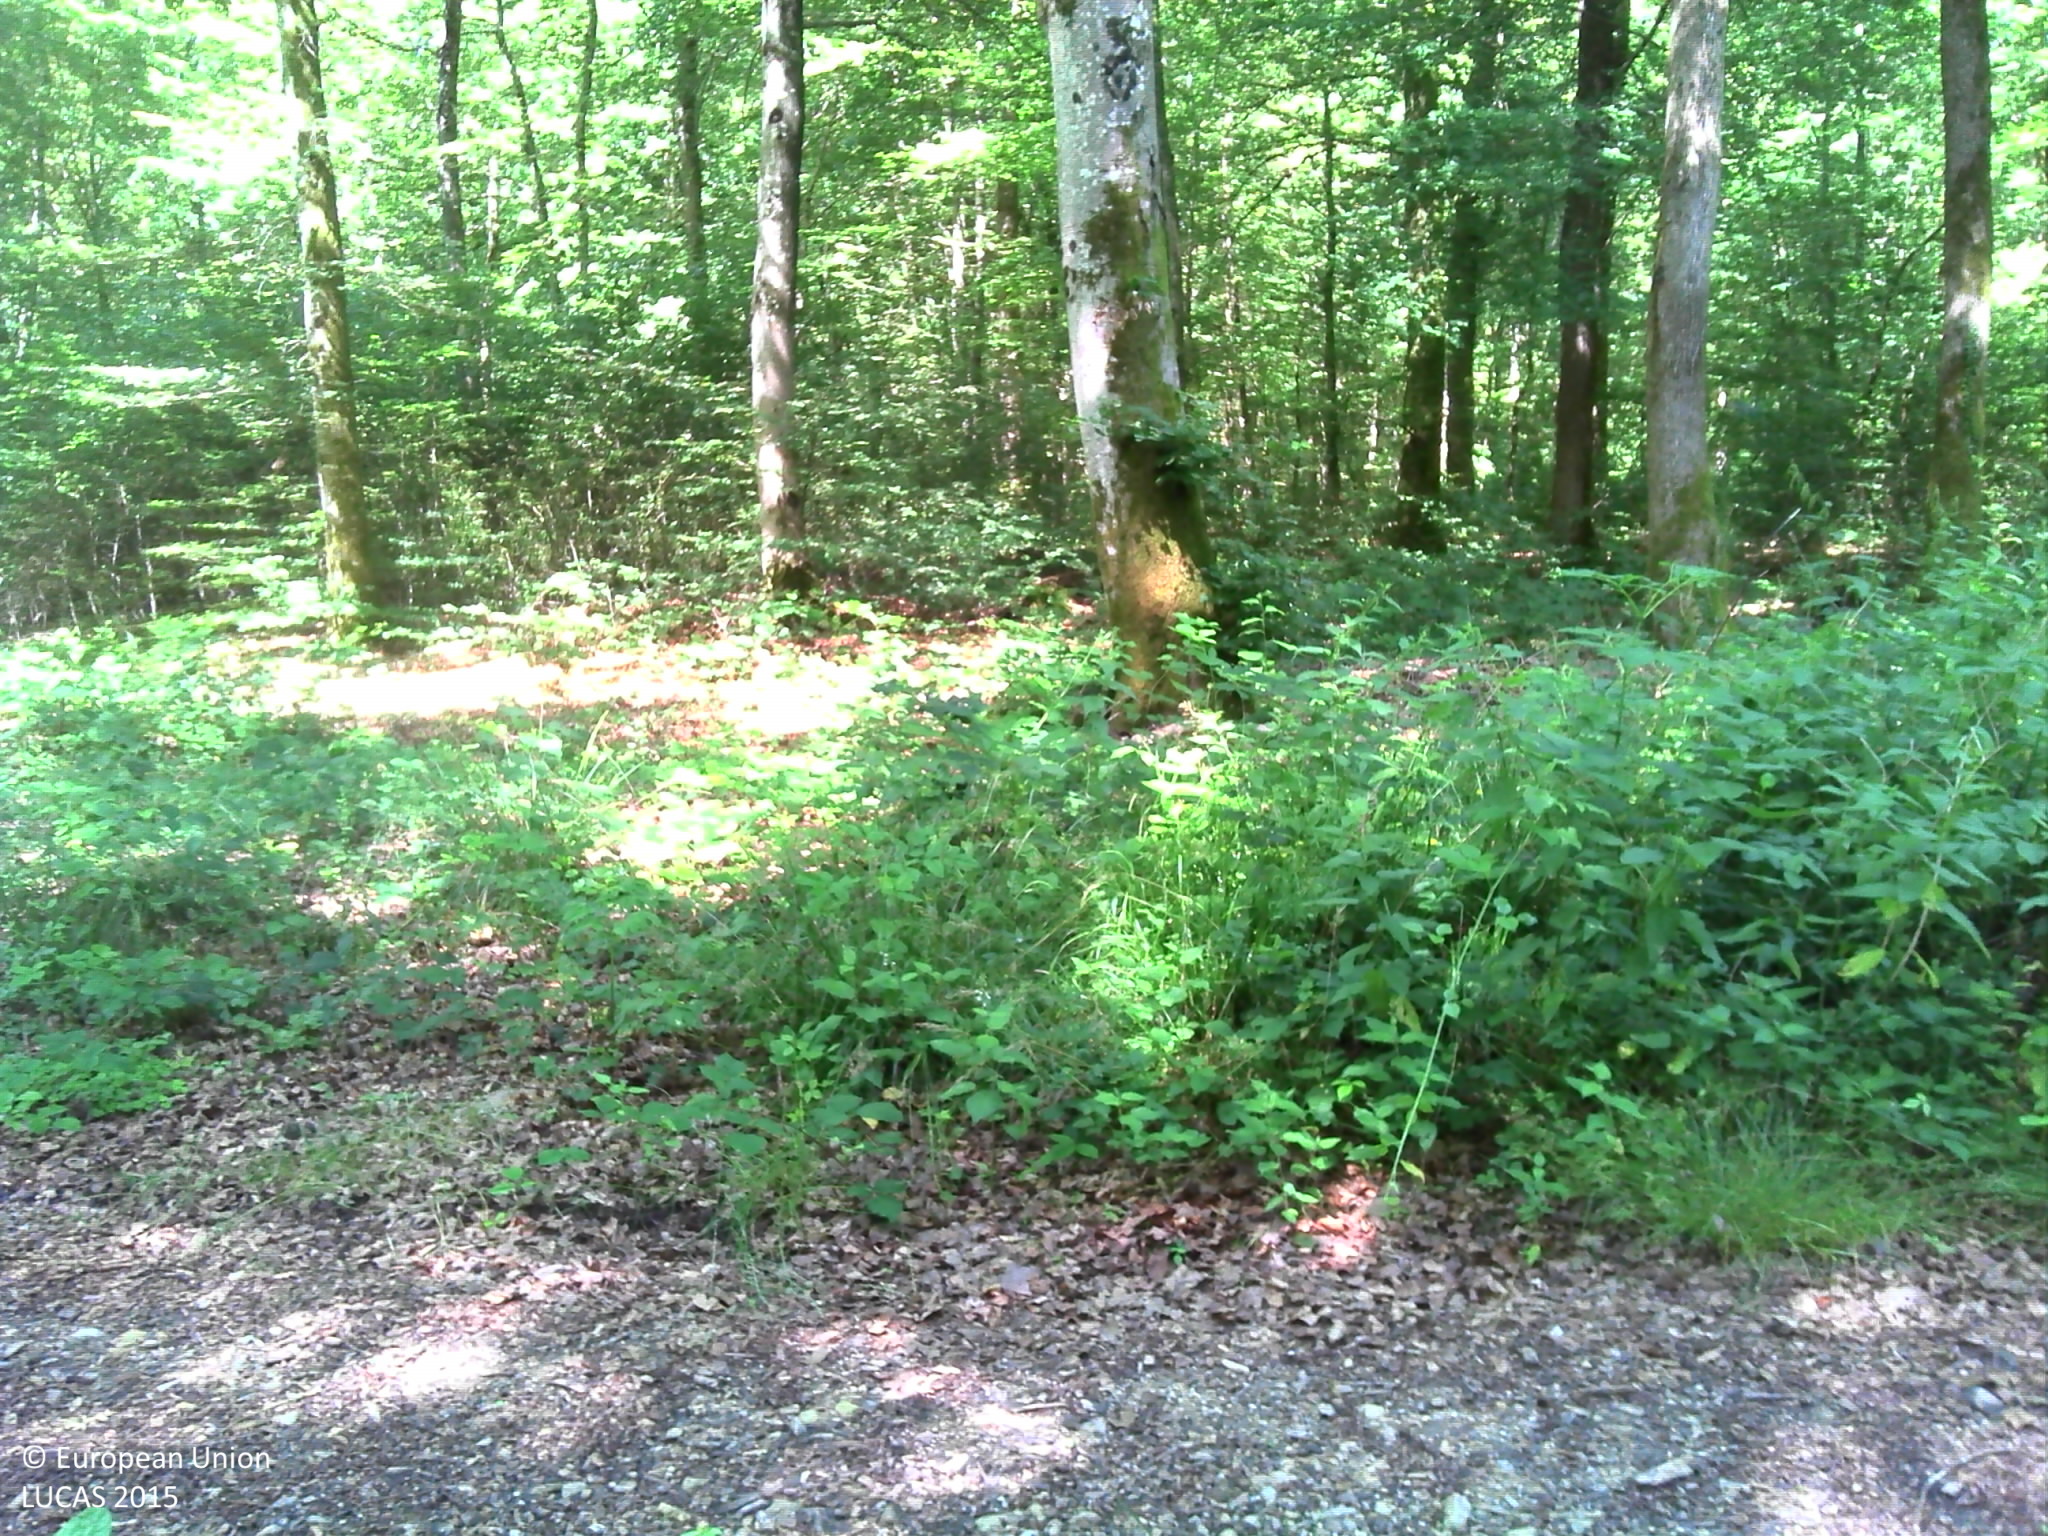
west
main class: Woodland
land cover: Broadleaved woodland
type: beech forest
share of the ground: > 75 %
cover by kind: broadleaved forest trees 90 %, shrubs 5 %, herbaceous plants 5 %
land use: Forestry
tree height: > 5 m
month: June
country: FR
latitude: 47.4552
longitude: 6.1948
